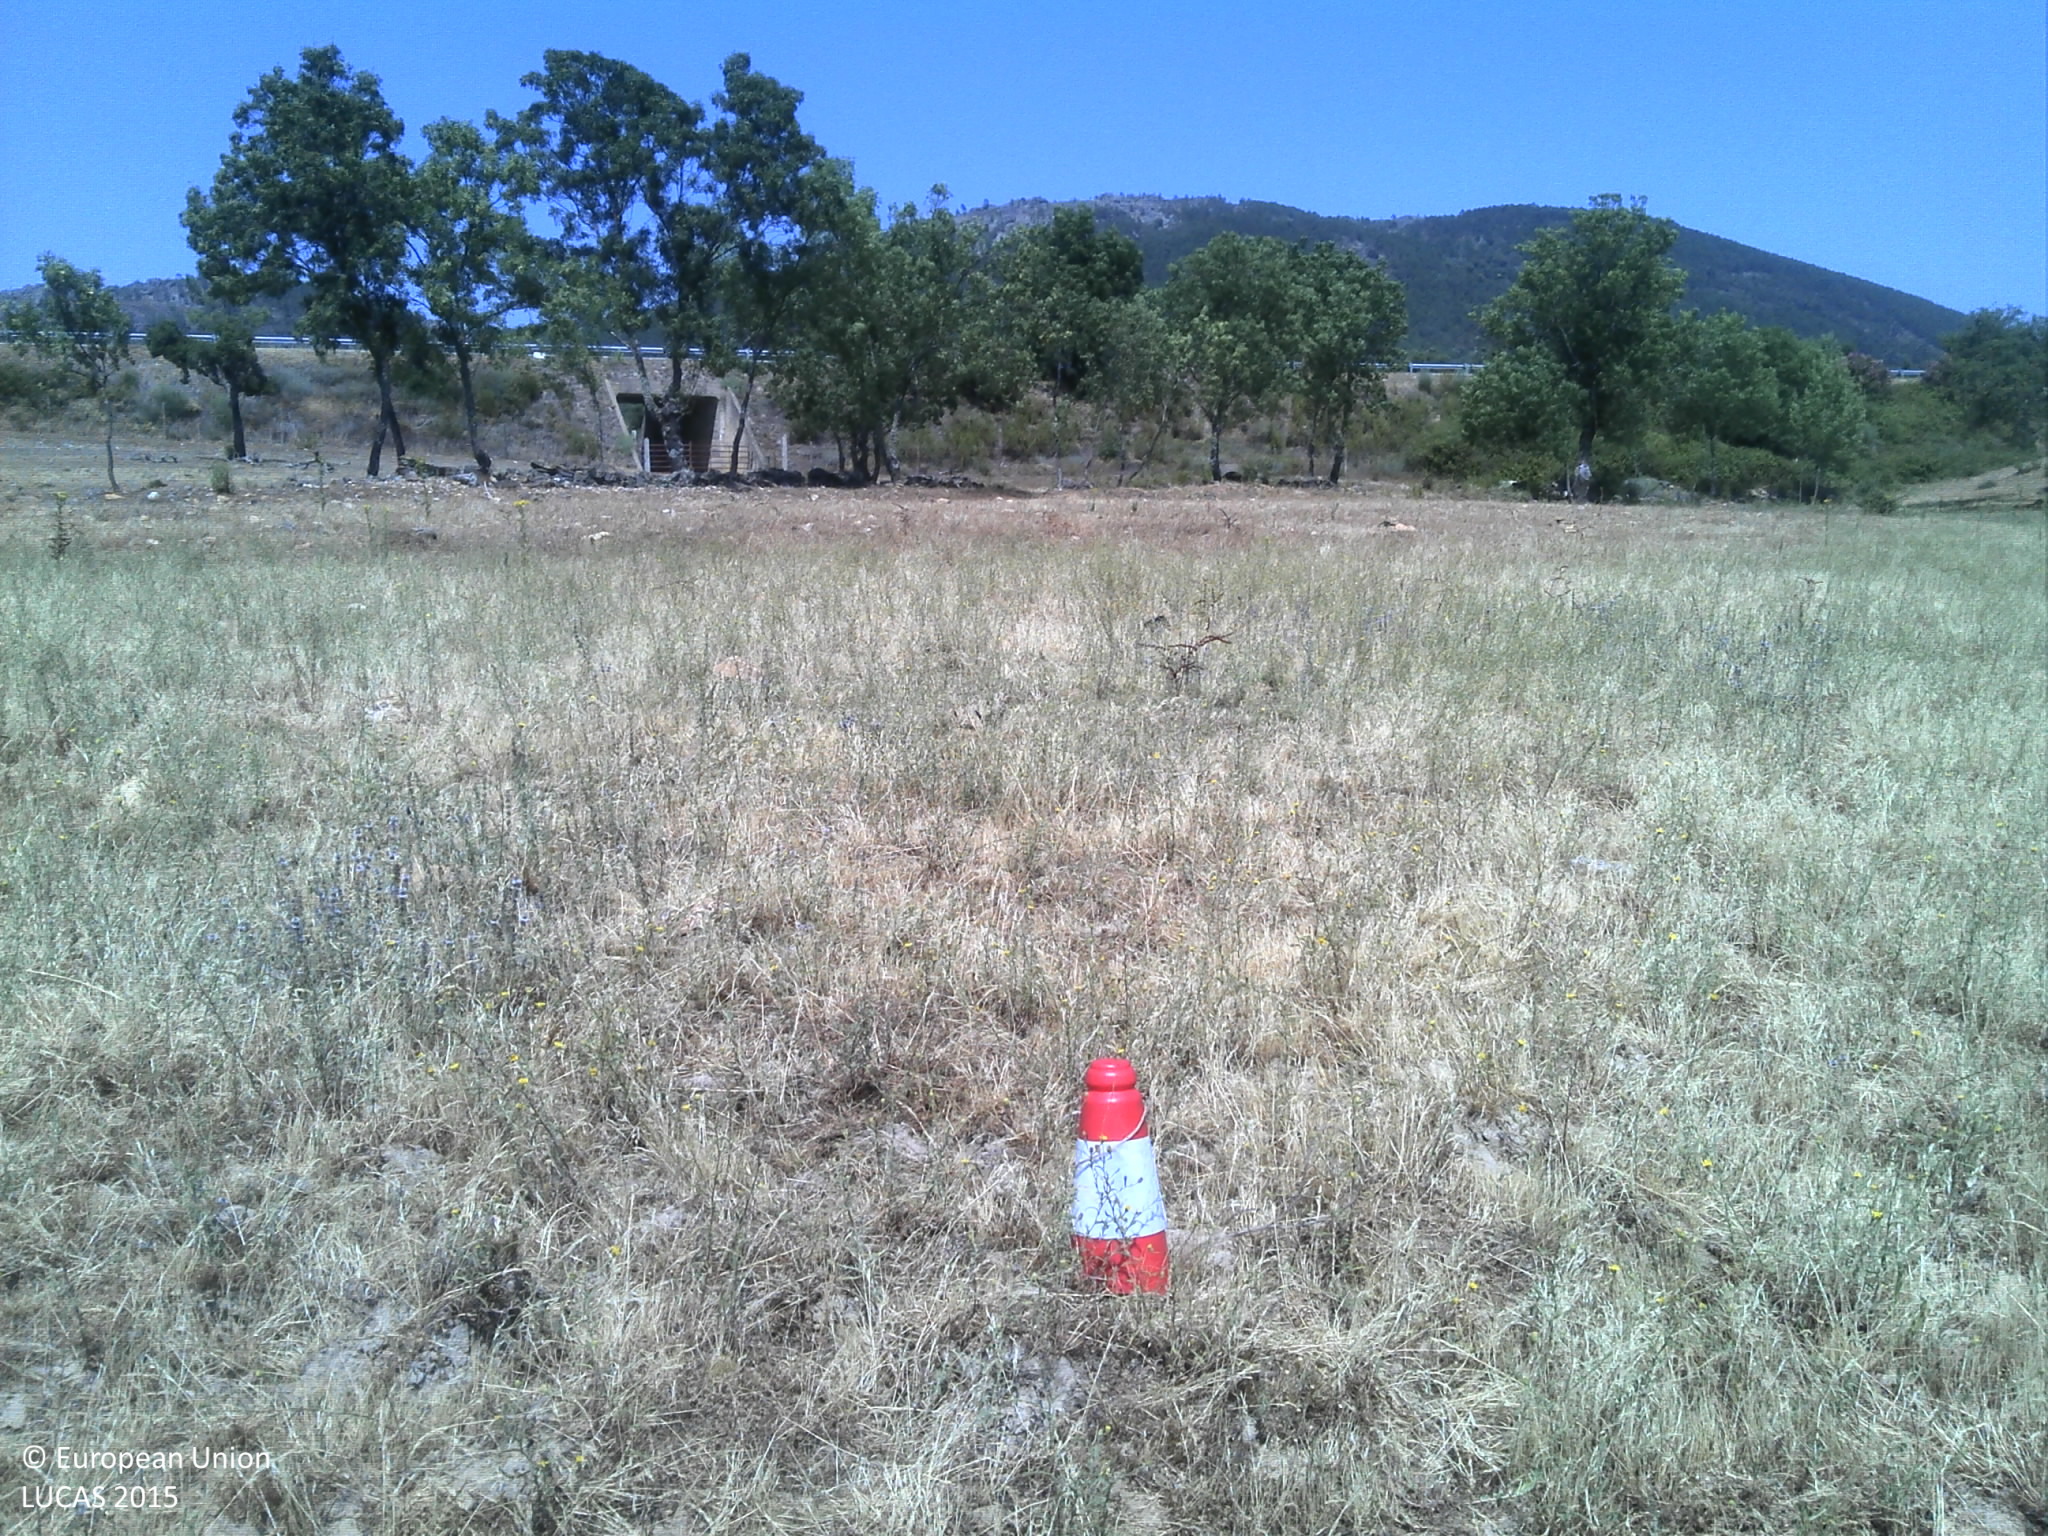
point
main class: Grassland
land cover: Grassland without tree/shrub cover
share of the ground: 50 - 75 %
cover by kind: herbaceous plants 65 %, unconsolidated bare surface 35 %
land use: Agriculture (excluding fallow land and kitchen gardens)
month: June
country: PT
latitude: 40.0254
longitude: -6.9994
